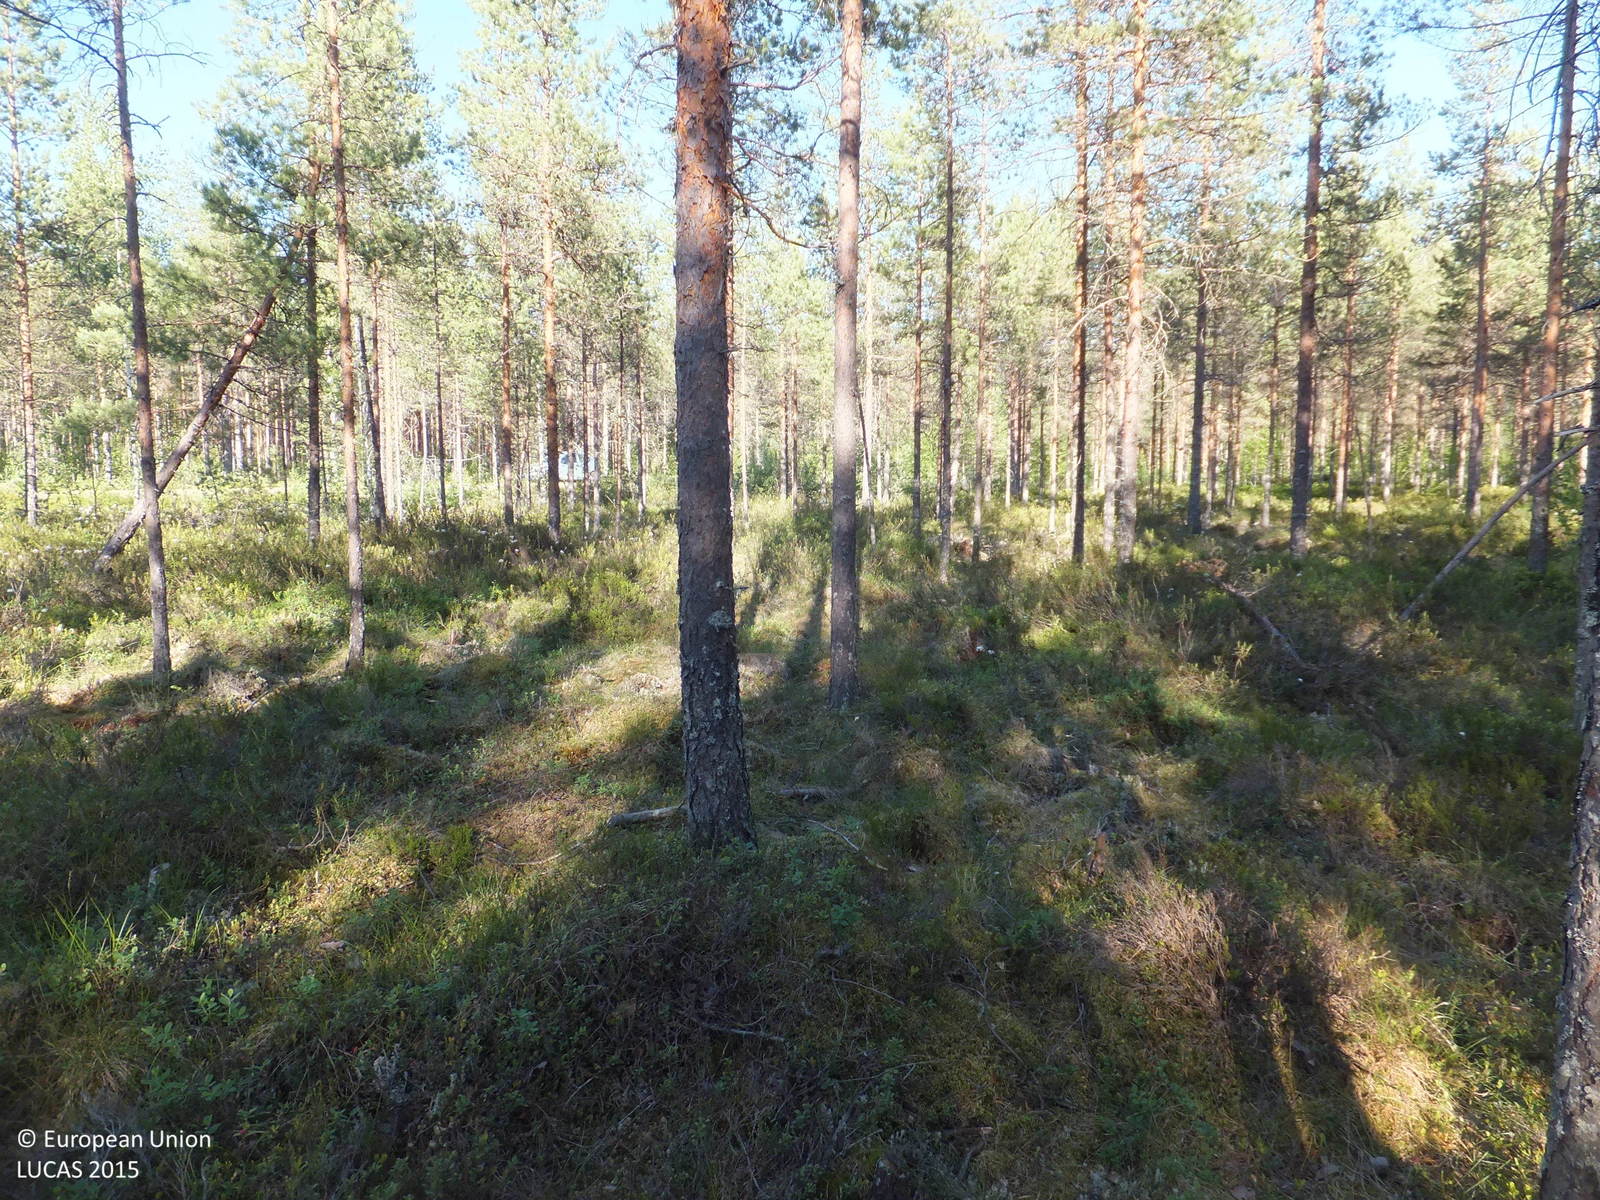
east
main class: Woodland
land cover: Pine dominated coniferous woodland
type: boreal forest
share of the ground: > 75 %
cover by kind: coniferous forest trees 80 %, broadleaved forest trees 5 %, shrubs 5 %, lichens and mosses 5 %, unconsolidated bare surface 5 %
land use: Forestry
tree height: > 5 m
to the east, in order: Pine dominated coniferous woodland; Paved roads, cycling and walking lanes; Pine dominated mixed woodland; Ditches and canals; Pine dominated mixed woodland; Pine dominated coniferous woodland; Ditches and canals; Pine dominated mixed woodland; Ditches and canals; Pine dominated mixed woodland; Ditches and canals; Pine dominated mixed woodland
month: June
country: FI
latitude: 63.3288
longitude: 24.2342
